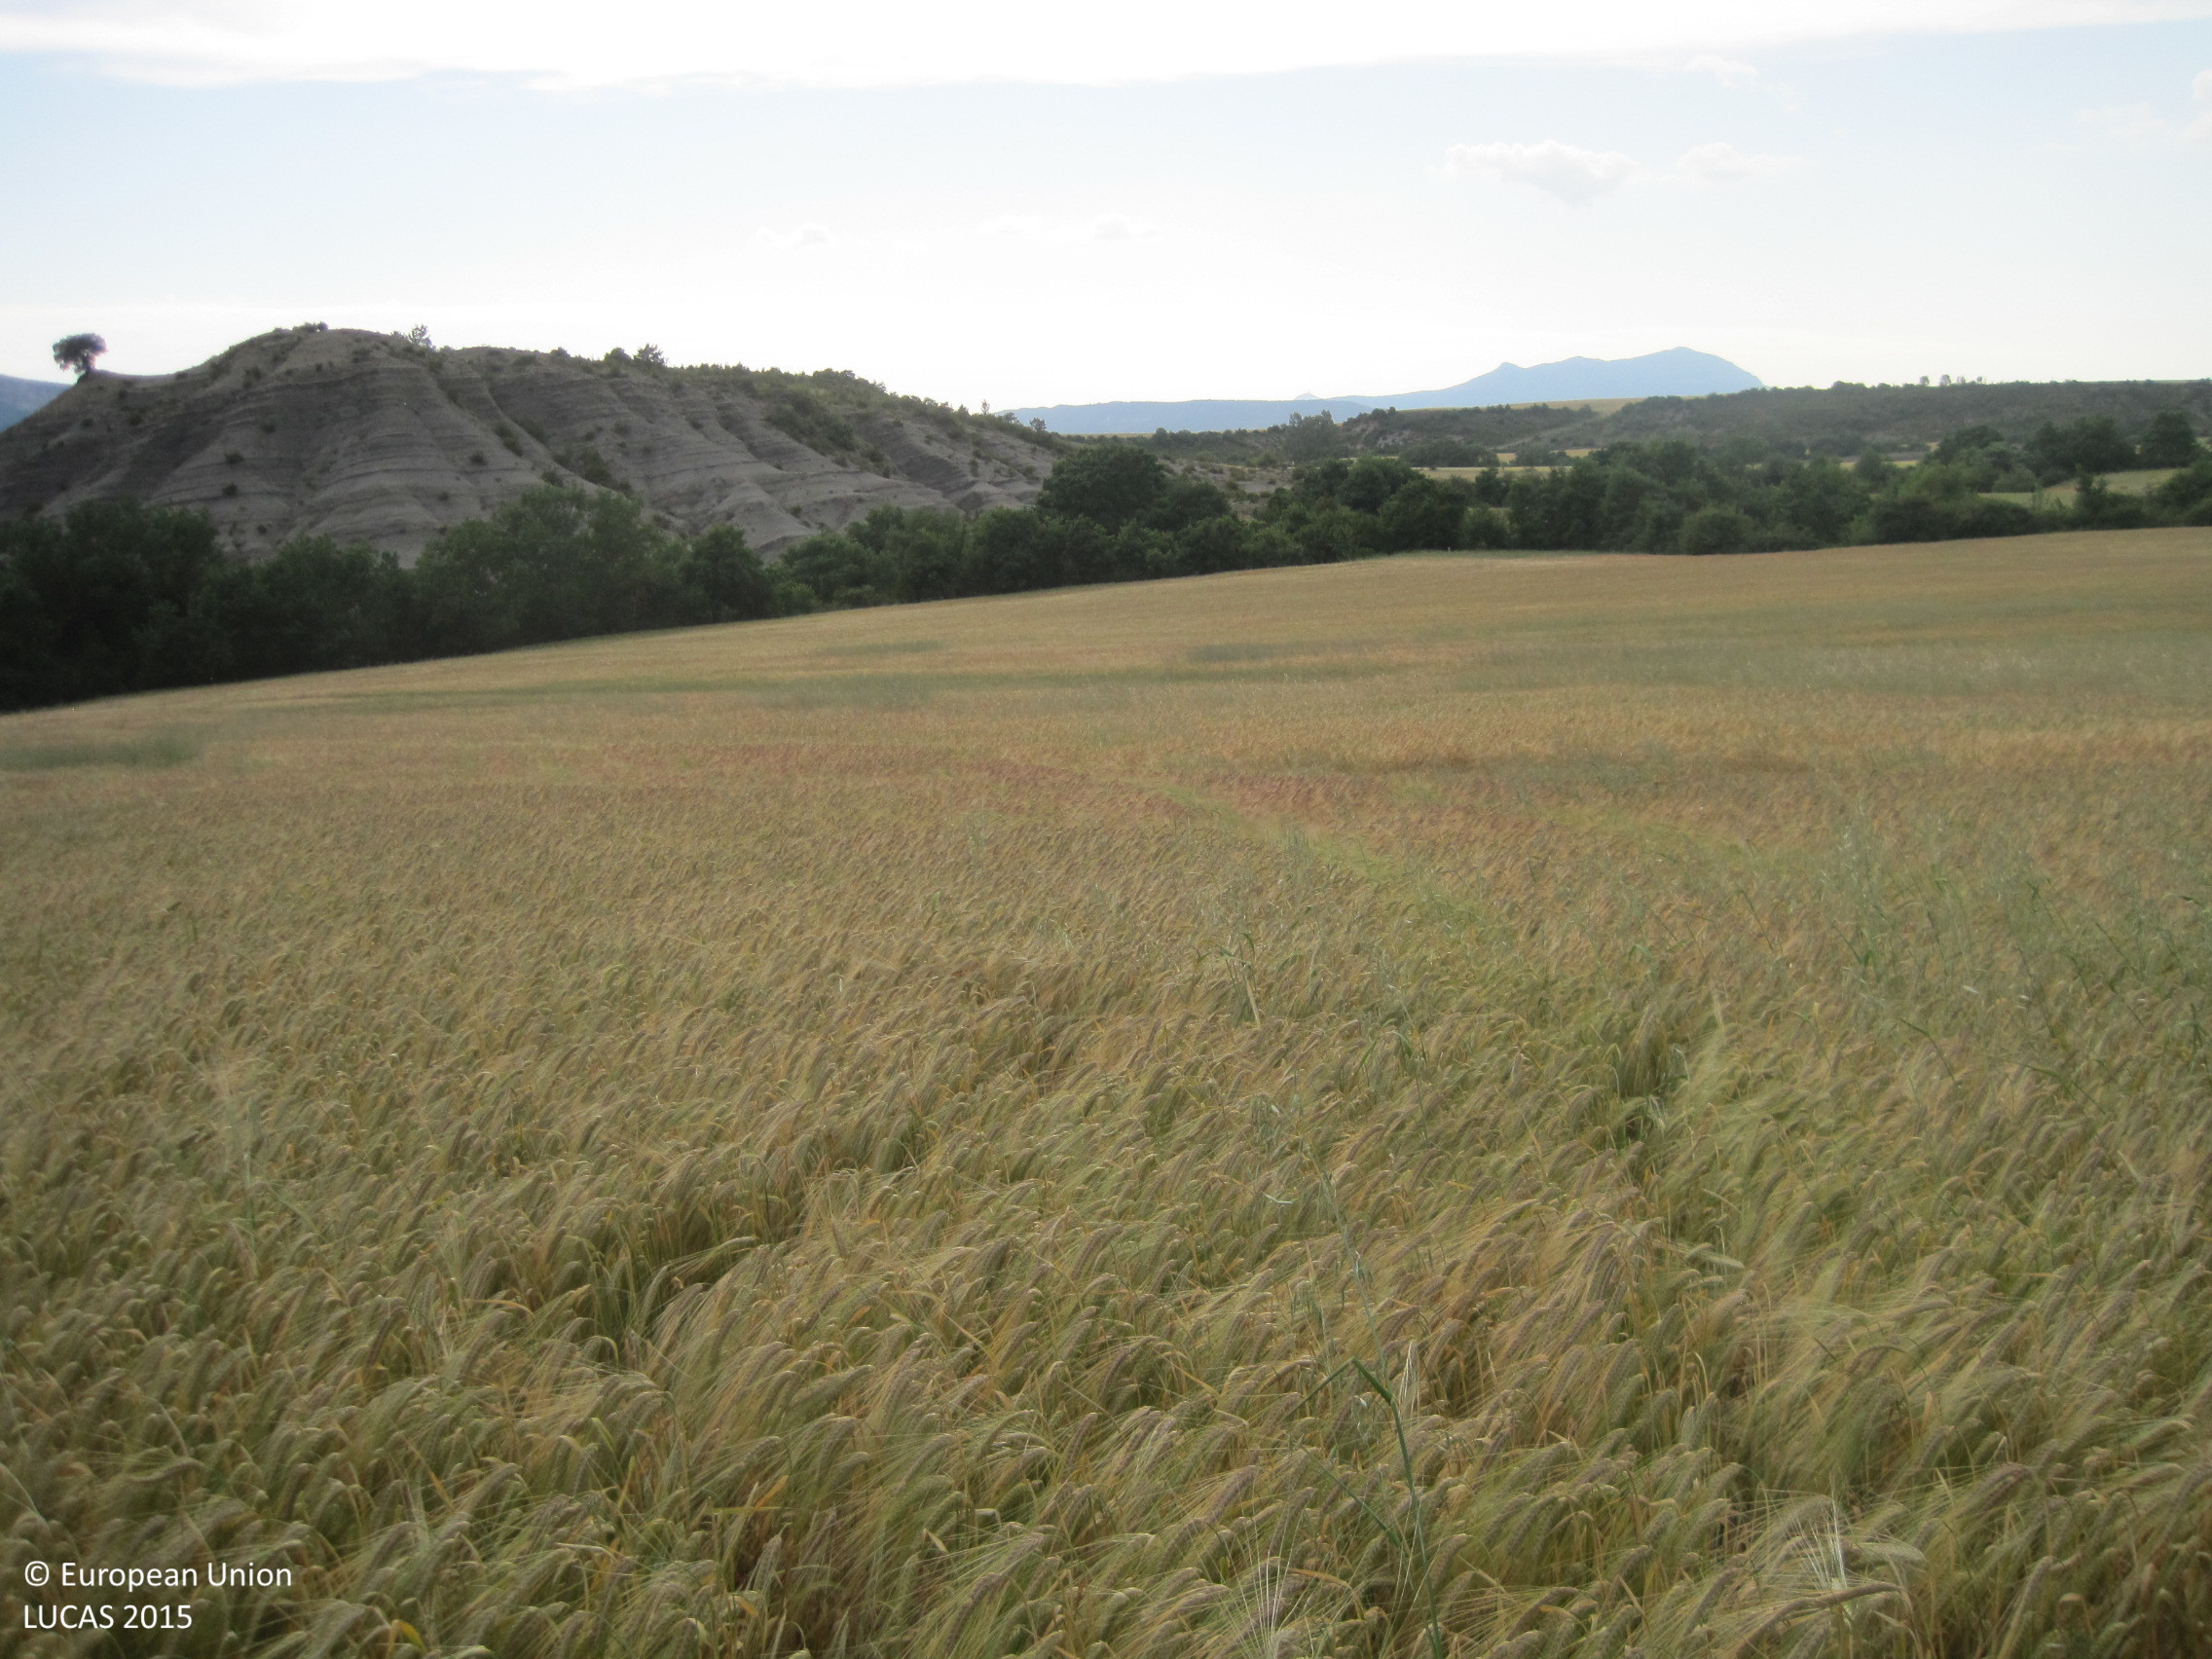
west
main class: Cropland
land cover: Barley
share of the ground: > 75 %
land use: Agriculture (excluding fallow land and kitchen gardens)
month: June
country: ES
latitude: 42.6659
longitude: -1.2218
